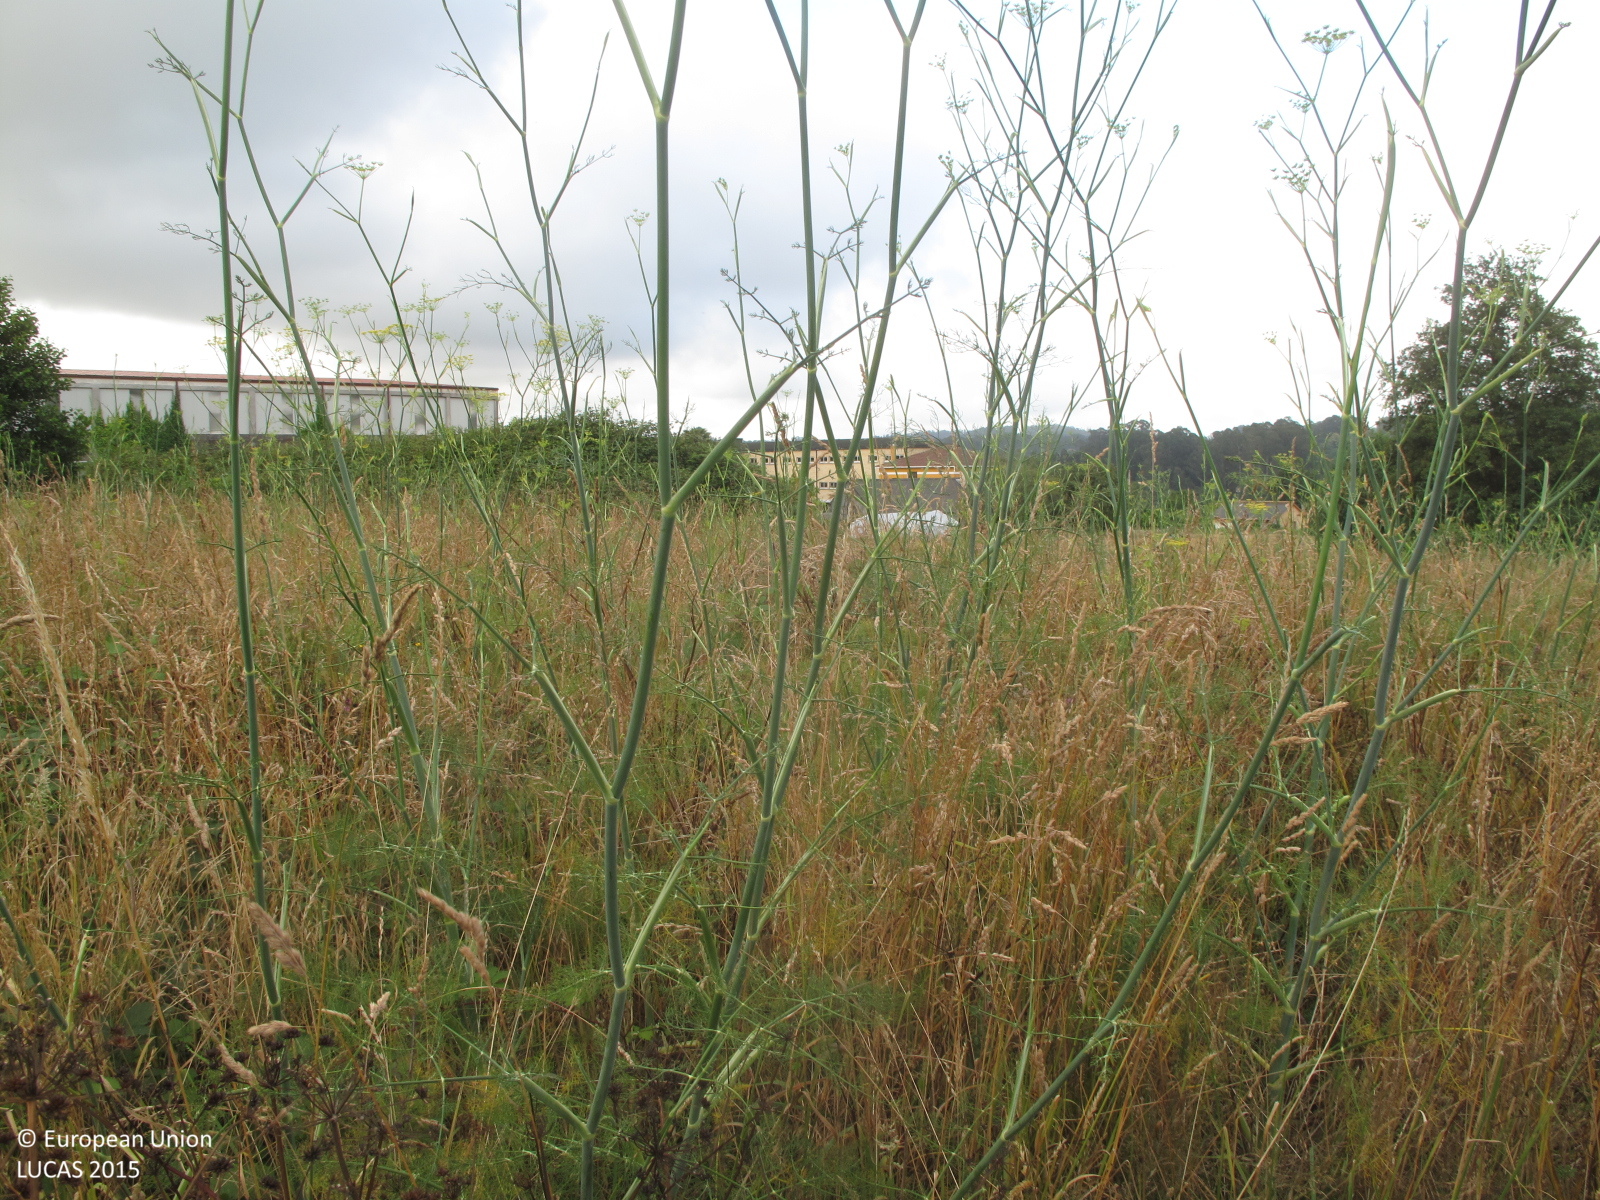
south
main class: Cropland
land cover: Maize
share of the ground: 25 - 50 %
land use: Agriculture (excluding fallow land and kitchen gardens)
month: July
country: ES
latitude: 43.3563
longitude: -8.2770
